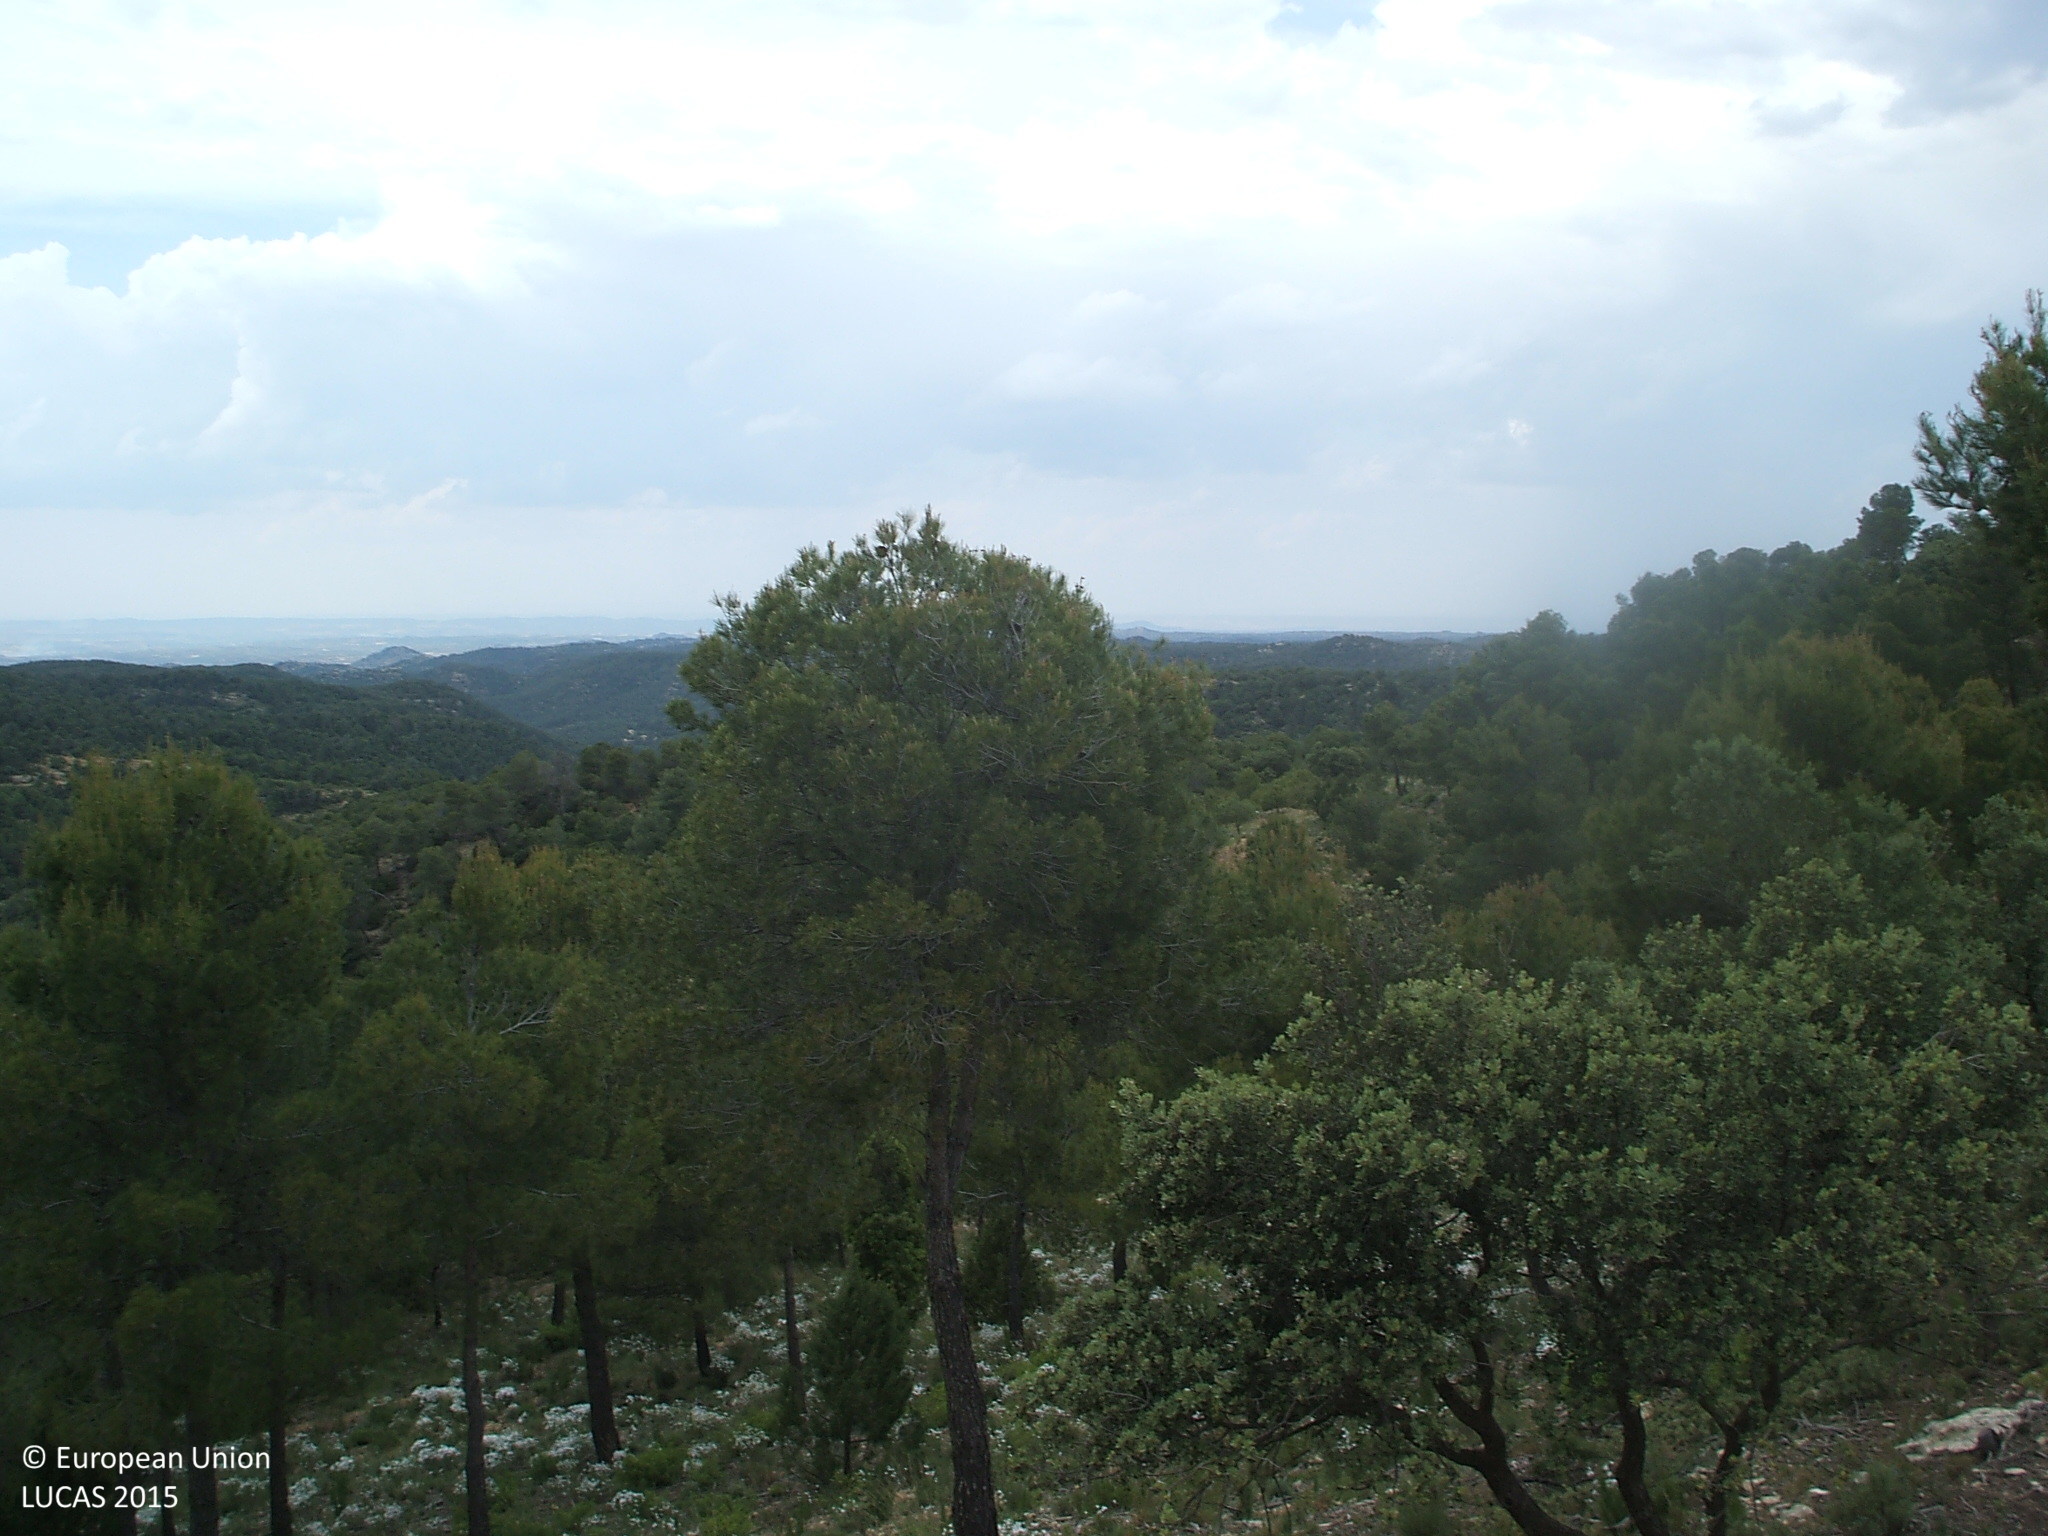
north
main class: Woodland
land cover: Pine dominated mixed woodland
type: coniferous forest of the mediterranean region
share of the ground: > 75 %
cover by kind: coniferous forest trees 75 %, broadleaved forest trees 25 %
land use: Semi-natural and natural areas not in use
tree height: > 5 m
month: June
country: ES
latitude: 40.8627
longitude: -0.0342
